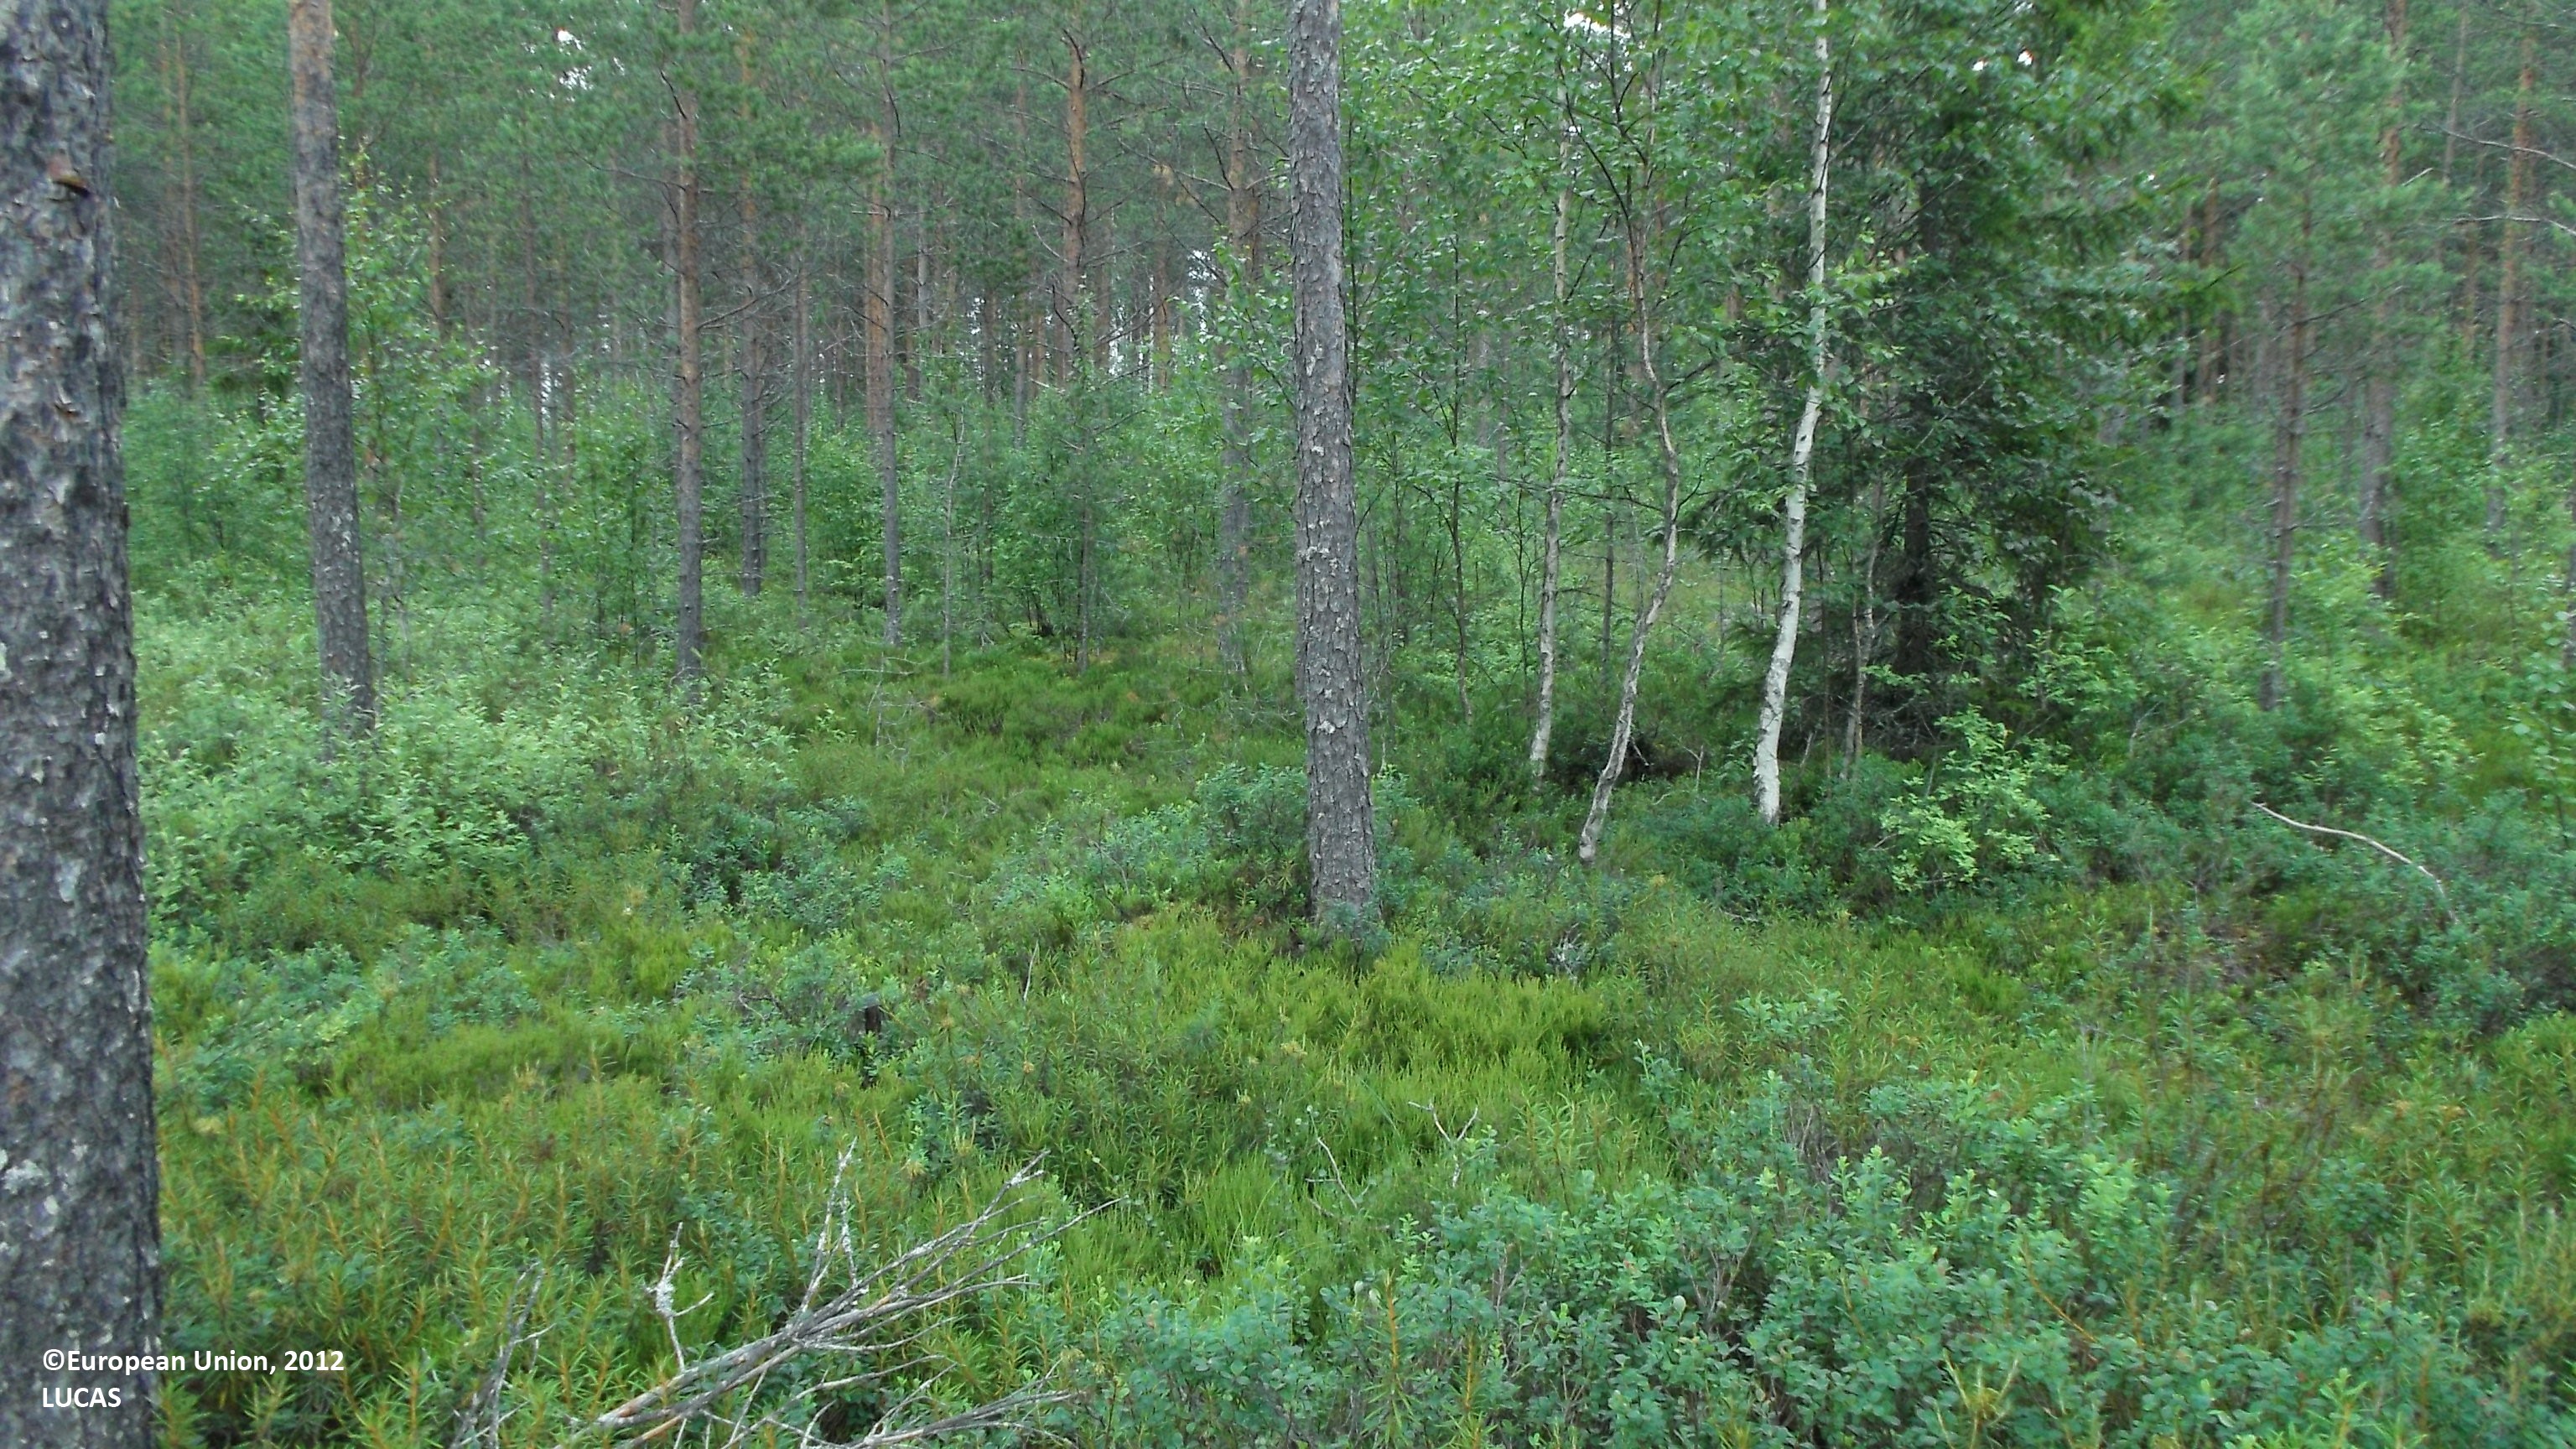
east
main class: Woodland
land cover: Pine dominated mixed woodland
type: boreal forest
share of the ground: 10 - 25 %
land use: Forestry
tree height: > 5 m
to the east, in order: Pine dominated mixed woodland; Ditches and canals; Abandoned hedges; Paved roads, cycling and walking lanes; Spontaneously vegetated surfaces; Ditches and canals; Pine dominated mixed woodland; Other mixed woodland; Ditches and canals; Other mixed woodland; Pine dominated mixed woodland
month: July
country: FI
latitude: 63.2658
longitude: 23.5137
